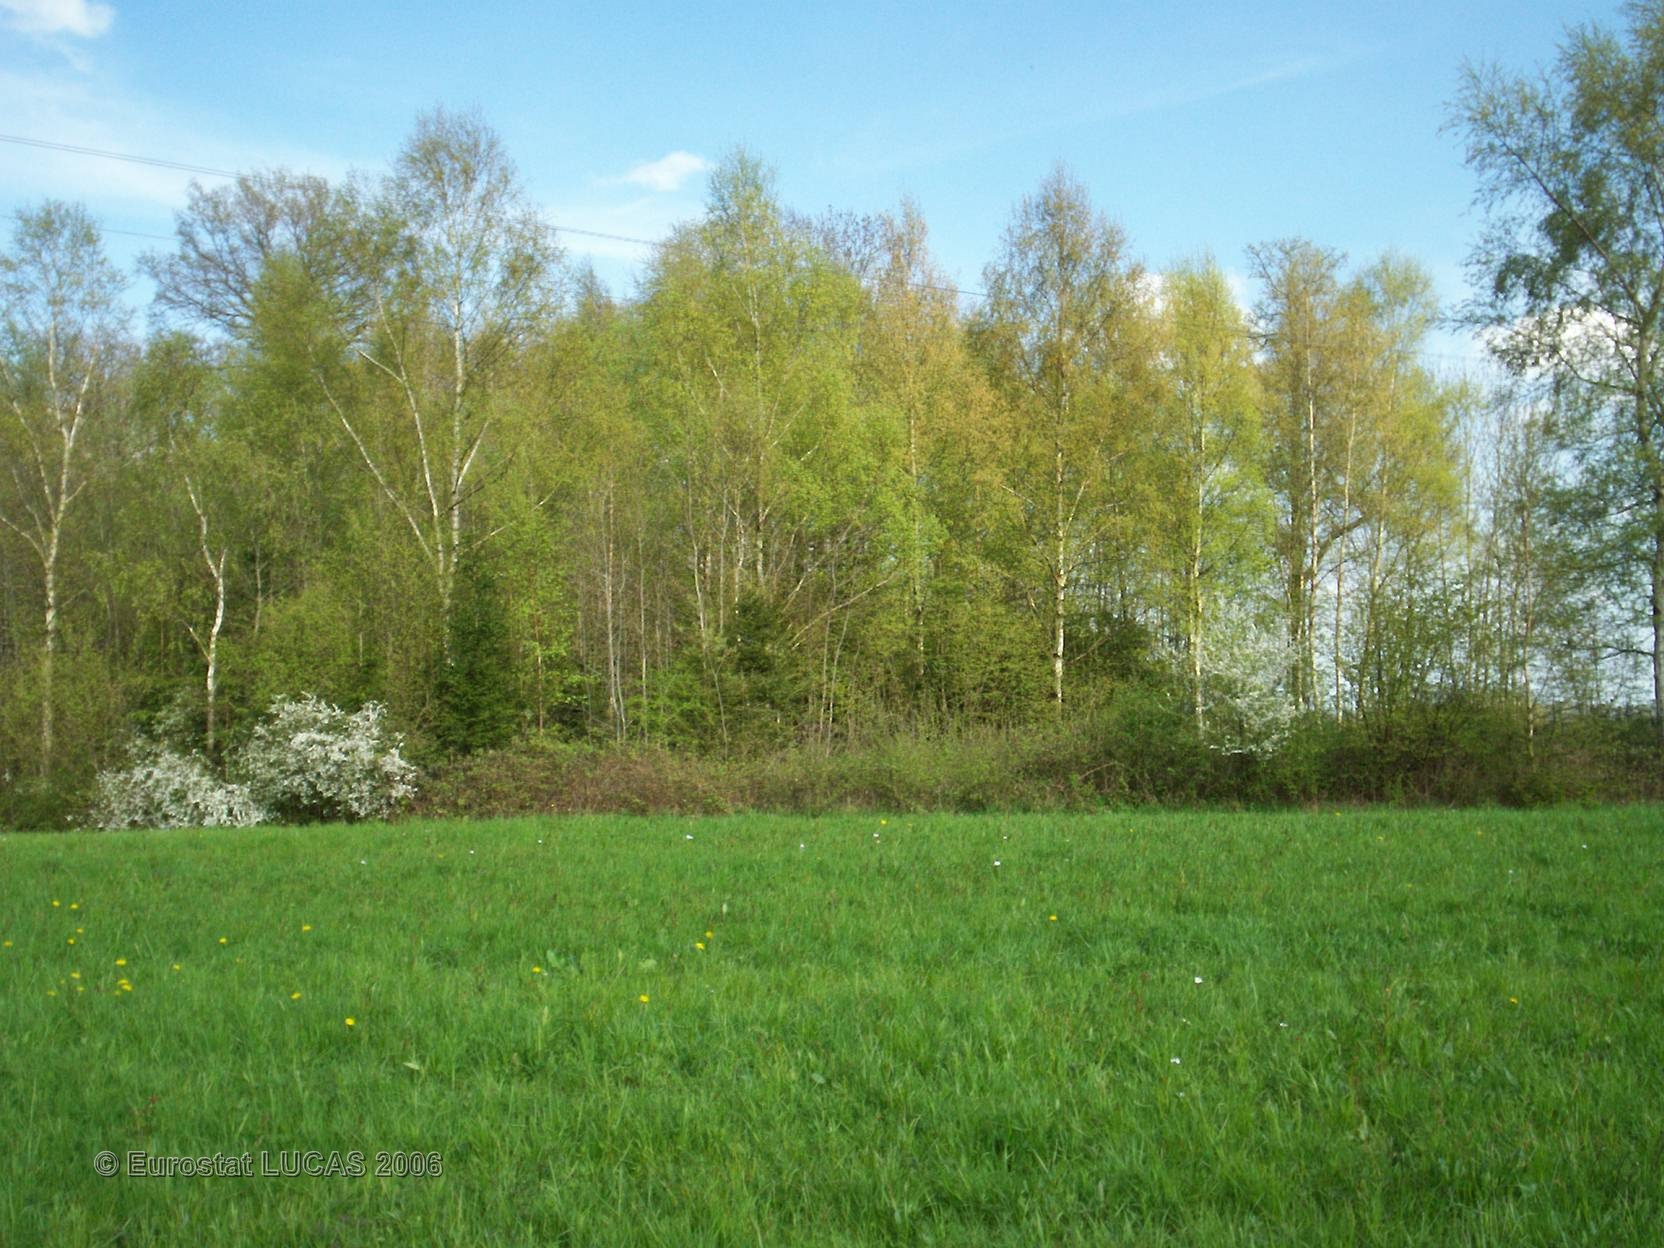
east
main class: Grassland
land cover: Grassland without tree/shrub cover
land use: Agriculture (excluding fallow land and kitchen gardens)
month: May
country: FR
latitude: 49.7886
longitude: 4.2866
